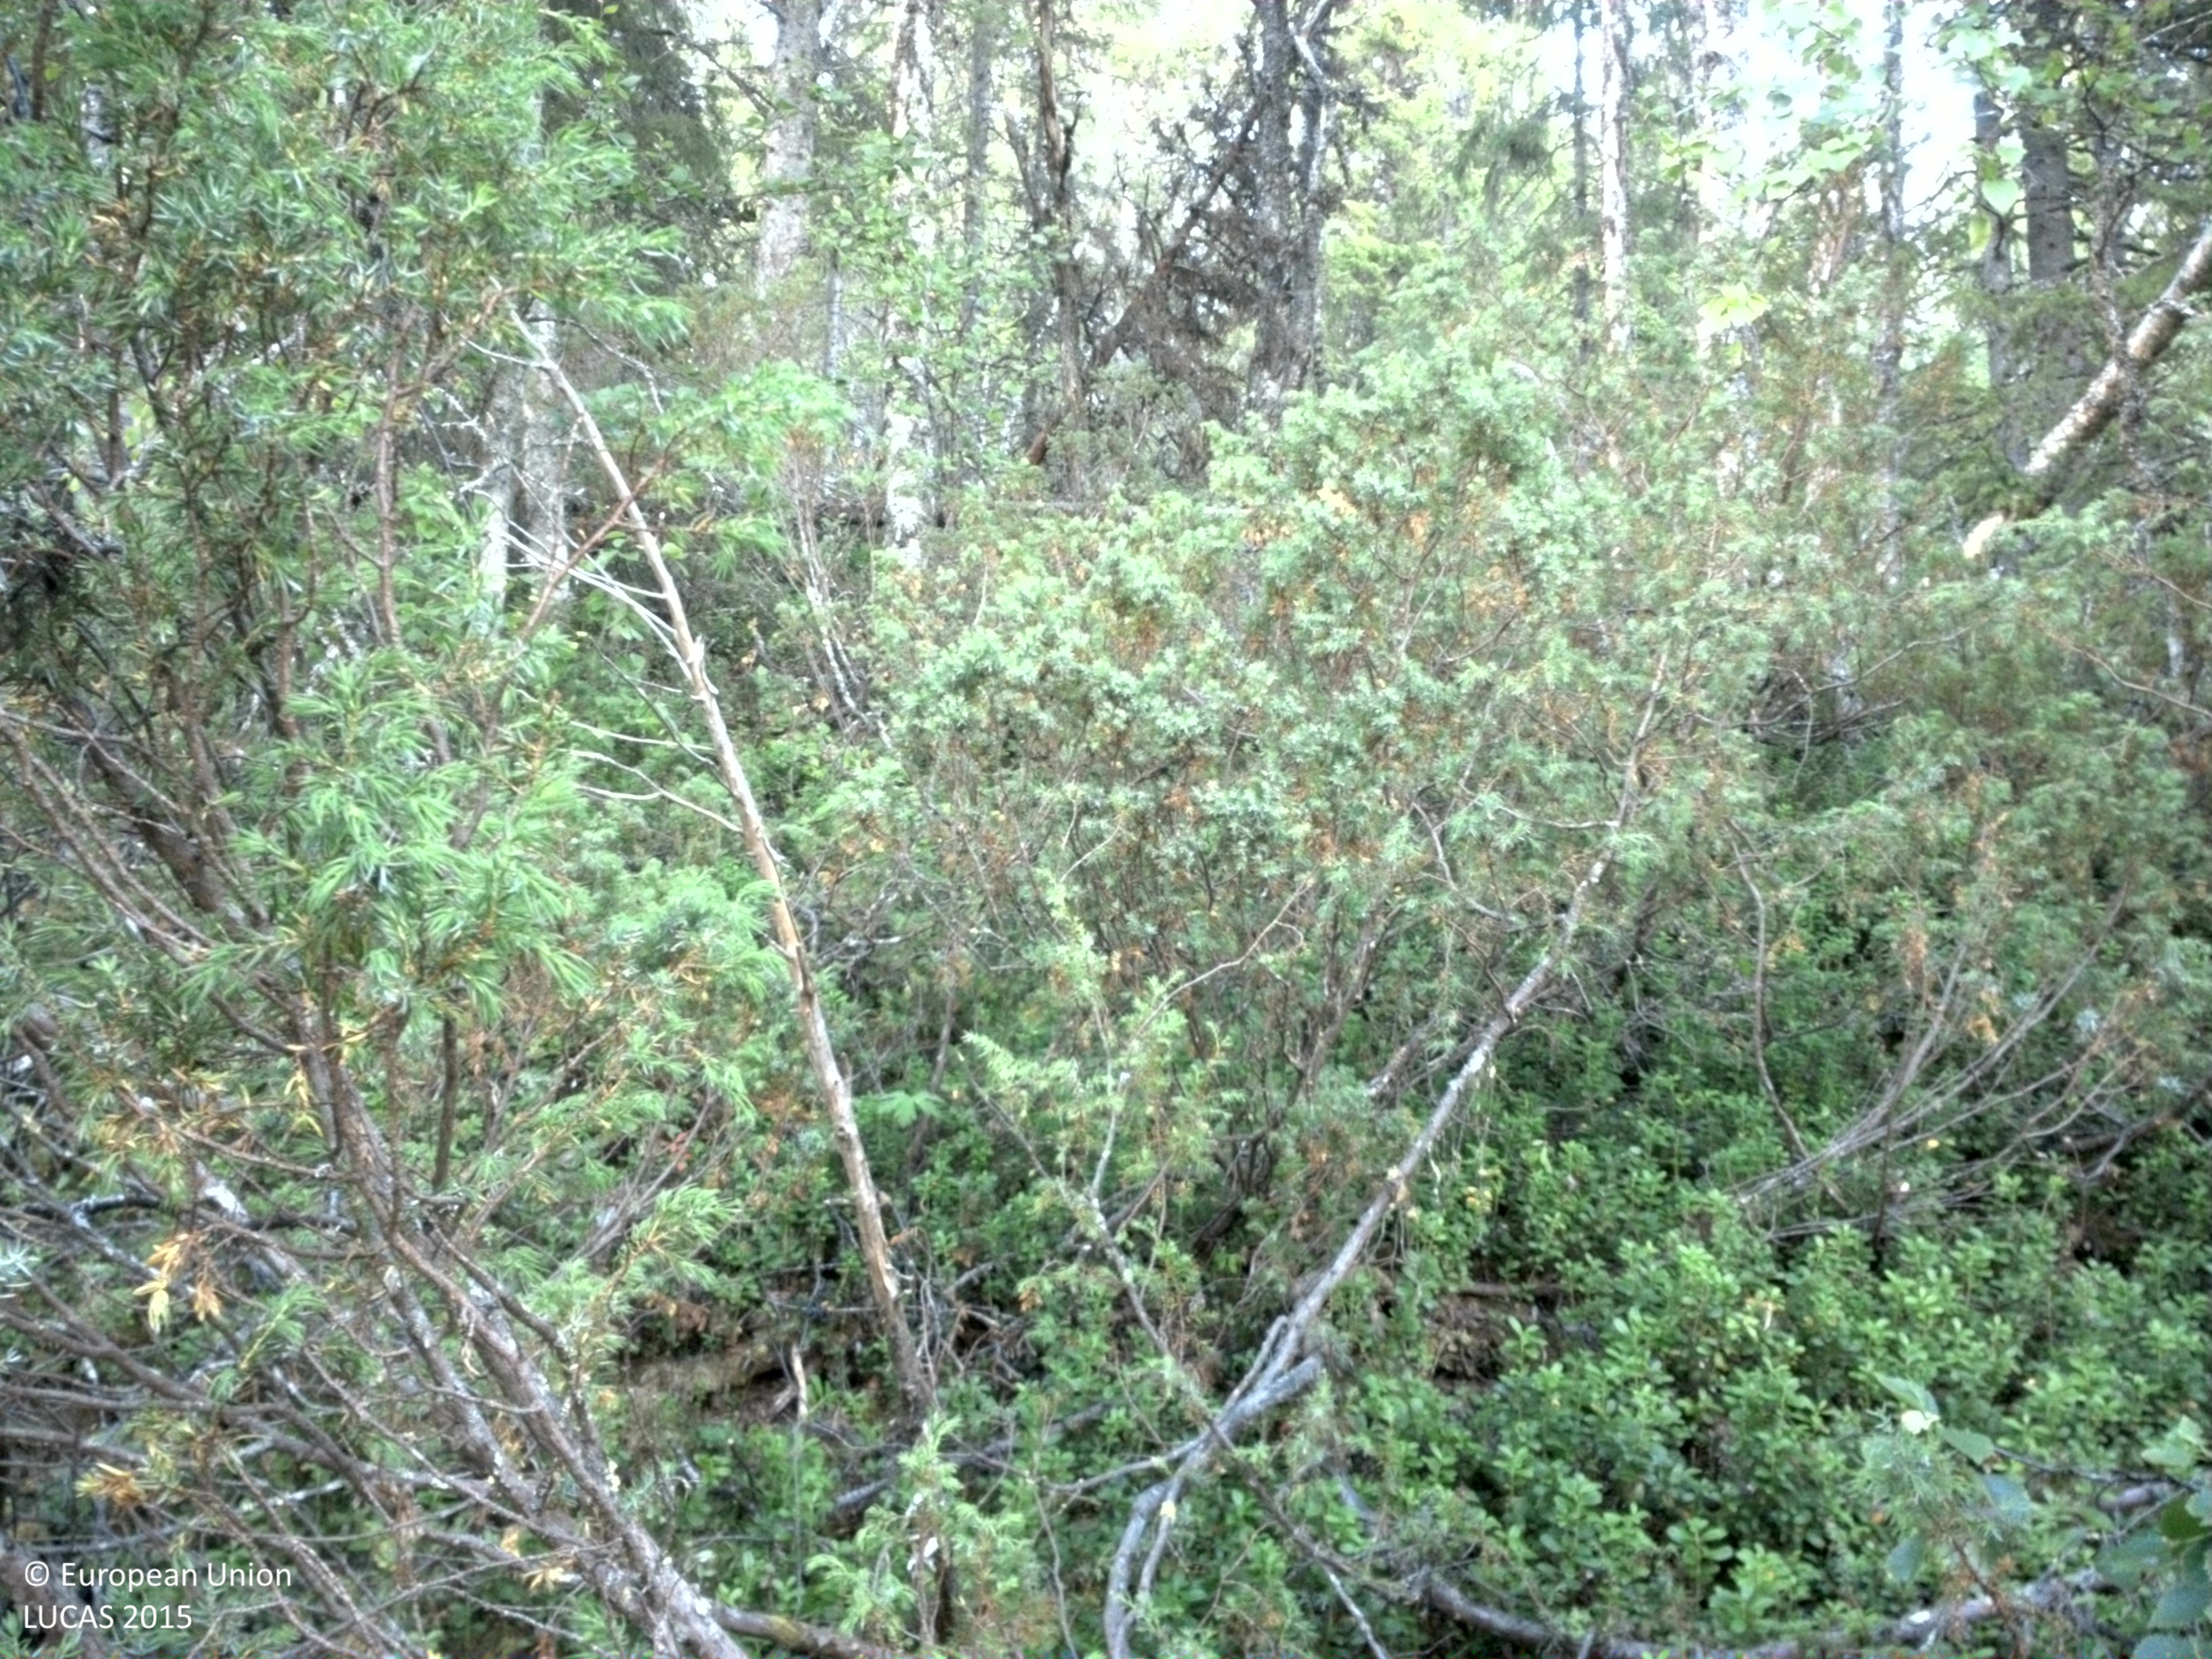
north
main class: Woodland
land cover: Spruce dominated mixed woodland
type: boreal forest
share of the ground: 25 - 50 %
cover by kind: shrubs 50 %, broadleaved forest trees 25 %, coniferous forest trees 20 %, lichens and mosses 5 %
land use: Forestry
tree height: > 5 m
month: September
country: SE
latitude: 64.9716
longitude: 16.5108
